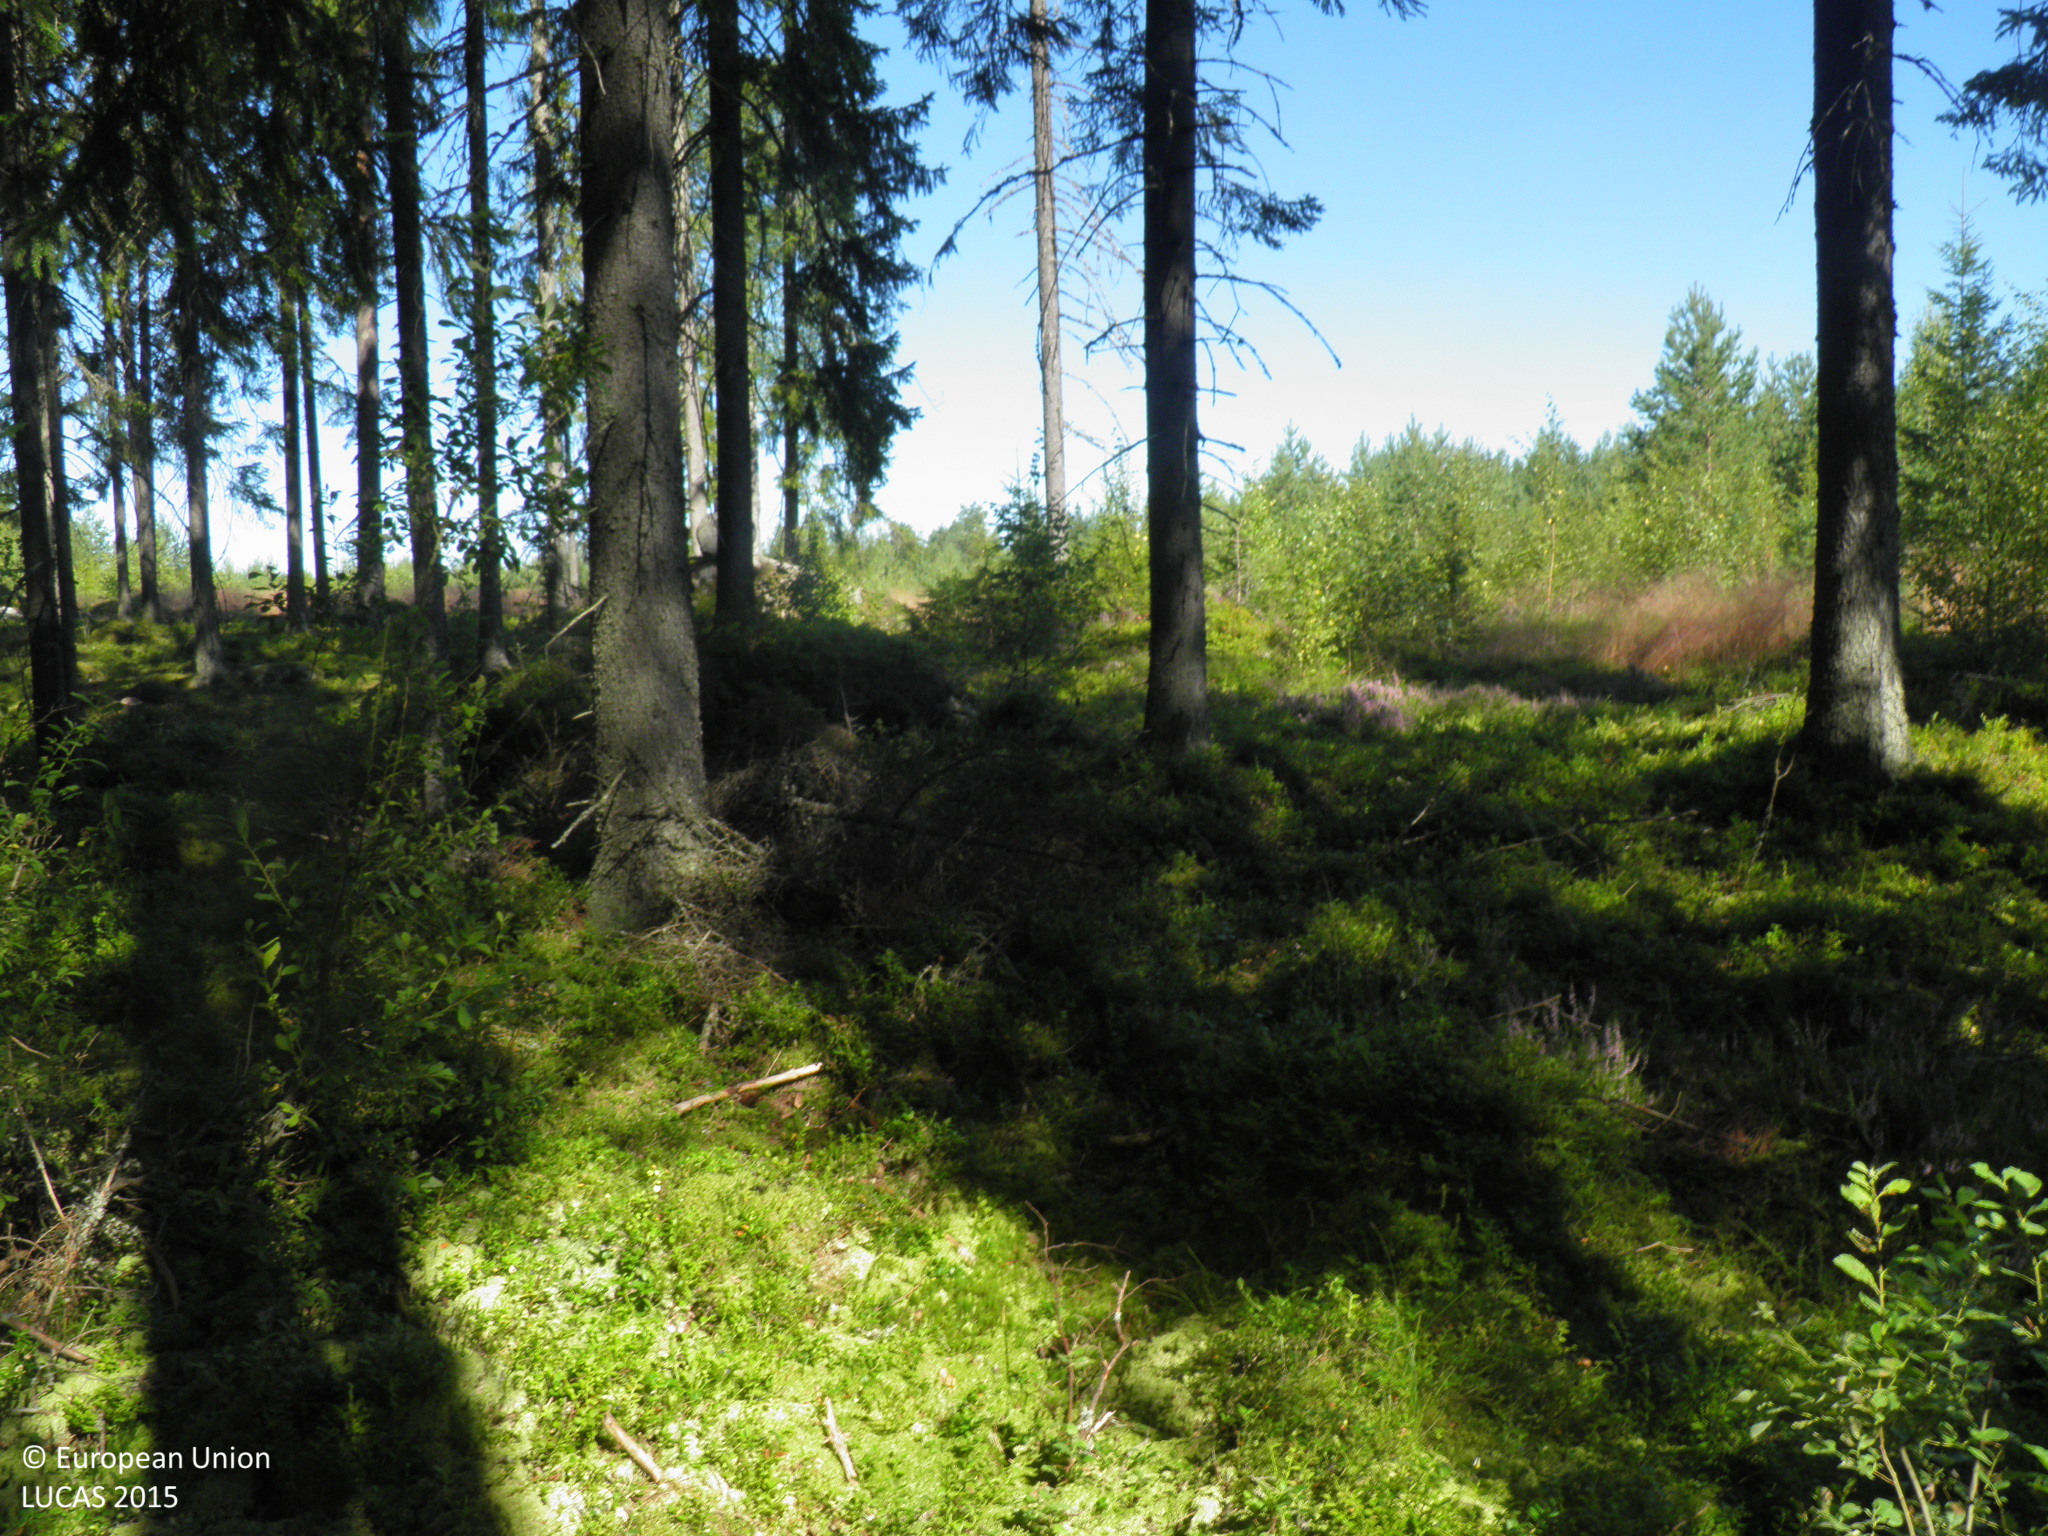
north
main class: Woodland
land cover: Spruce dominated coniferous woodland
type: hemiboreal forest and nemoral coniferous forest and mixed broadleaved-coniferous forest
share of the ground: > 75 %
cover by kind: coniferous forest trees 75 %, shrubs 25 %
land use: Forestry
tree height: > 5 m
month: August
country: FI
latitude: 60.7753
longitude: 21.6056
